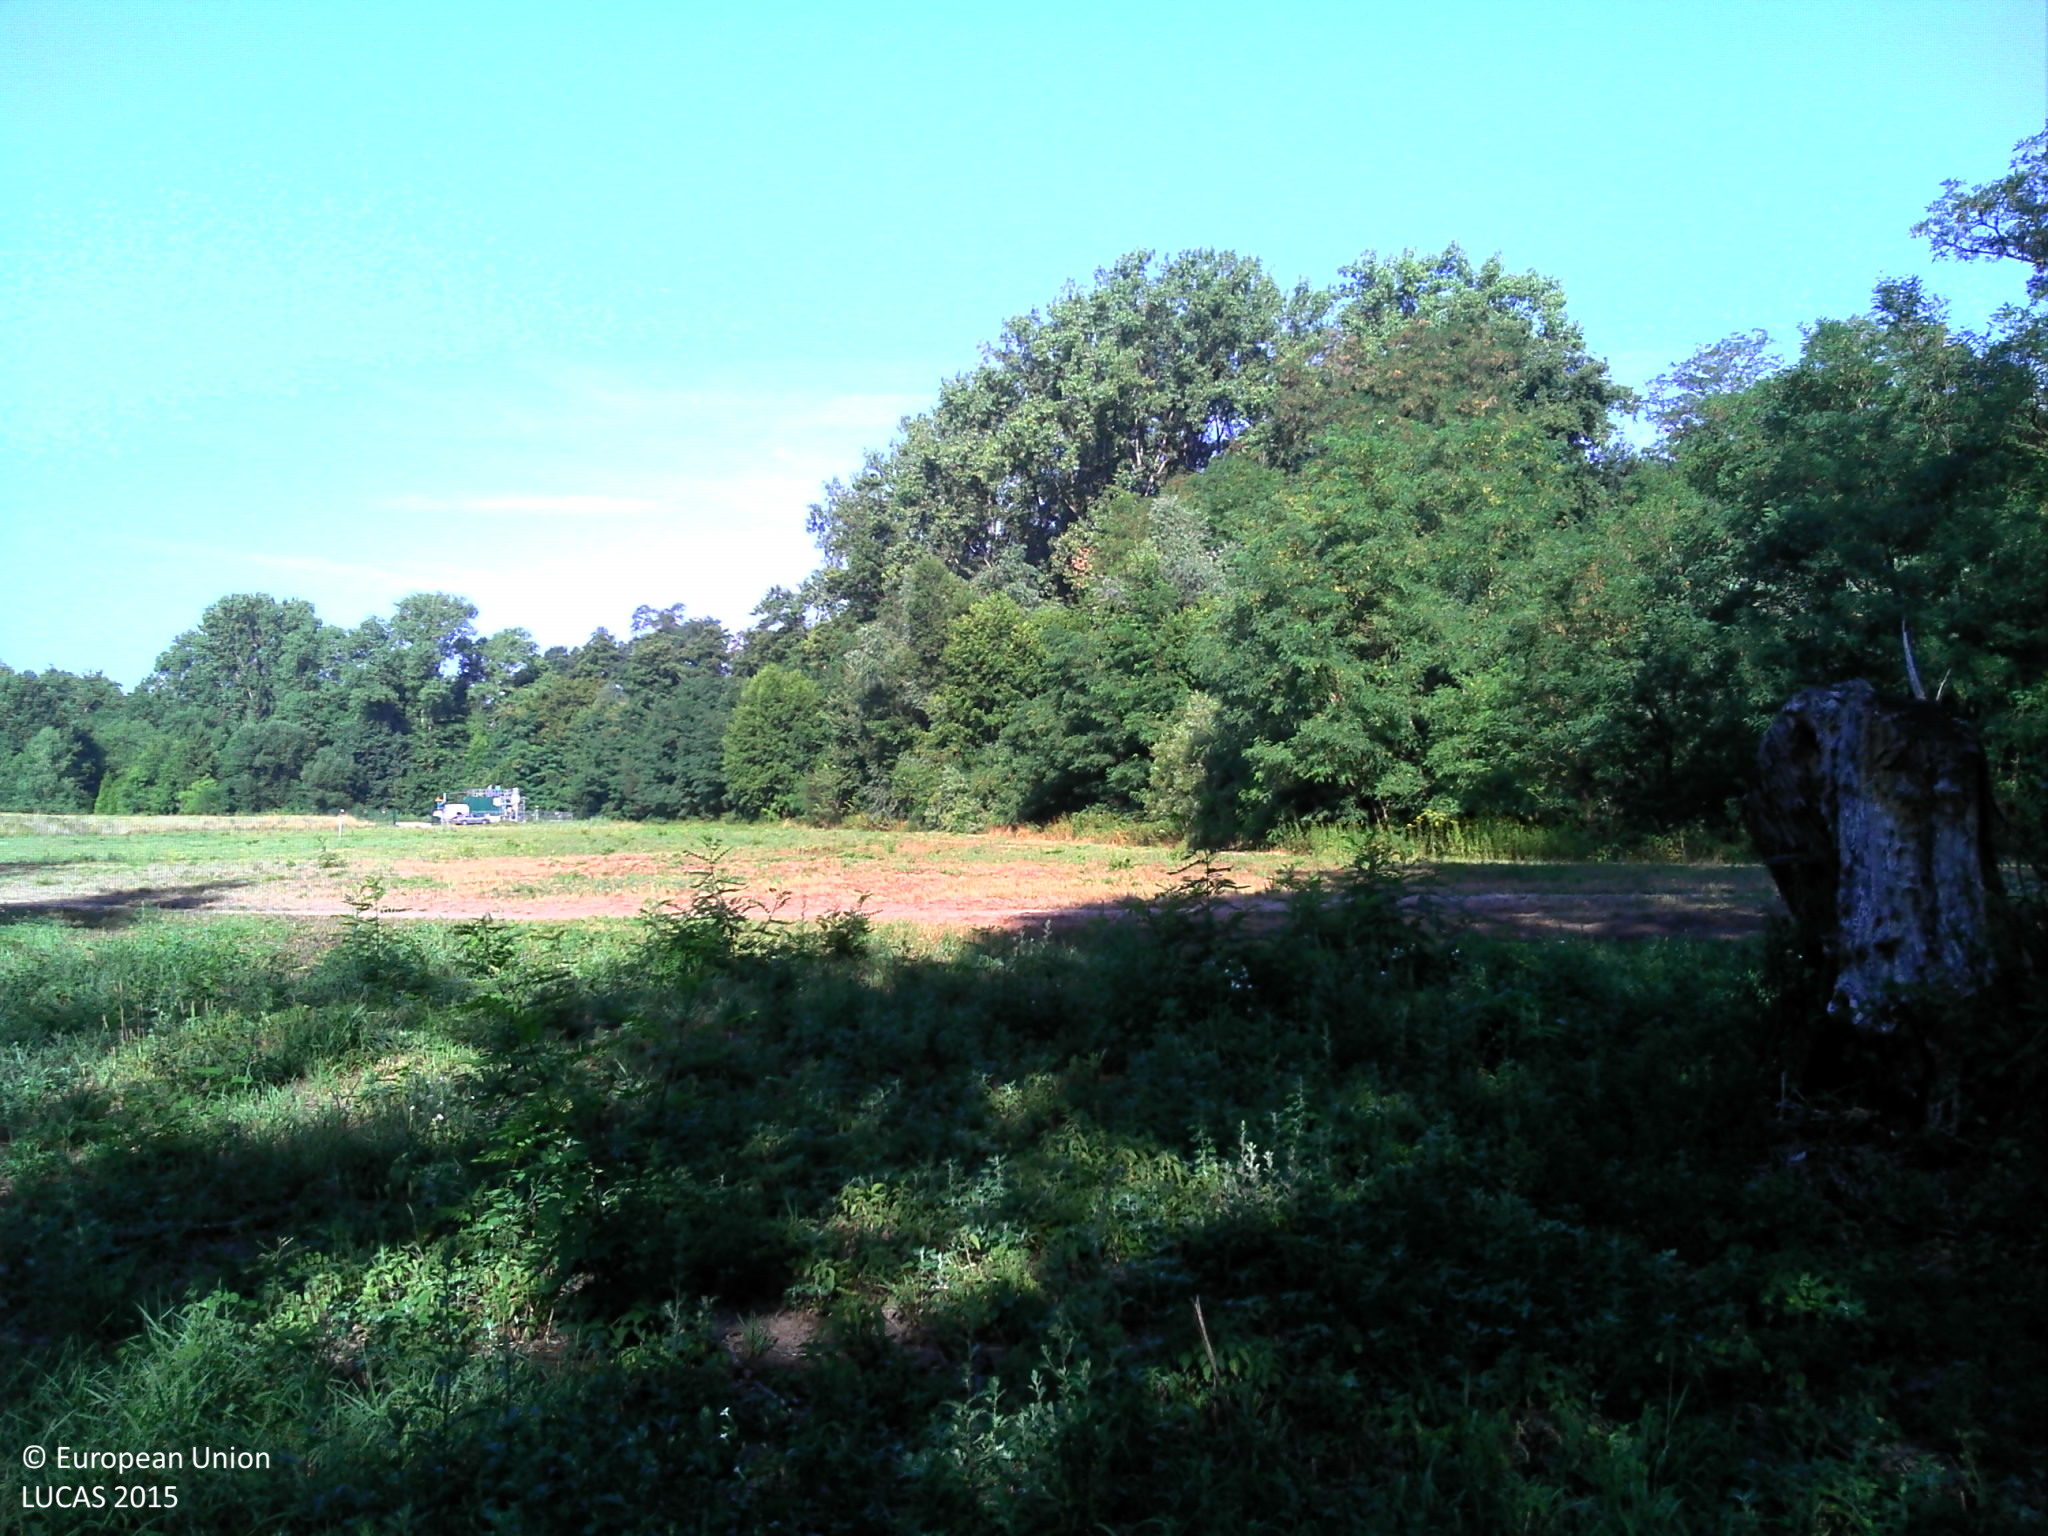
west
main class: Woodland
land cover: Broadleaved woodland
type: mesophytic deciduous forest
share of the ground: > 75 %
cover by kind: broadleaved forest trees 50 %, herbaceous plants 50 %
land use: Forestry
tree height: > 5 m
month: August
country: FR
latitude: 48.8348
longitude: 7.9708
